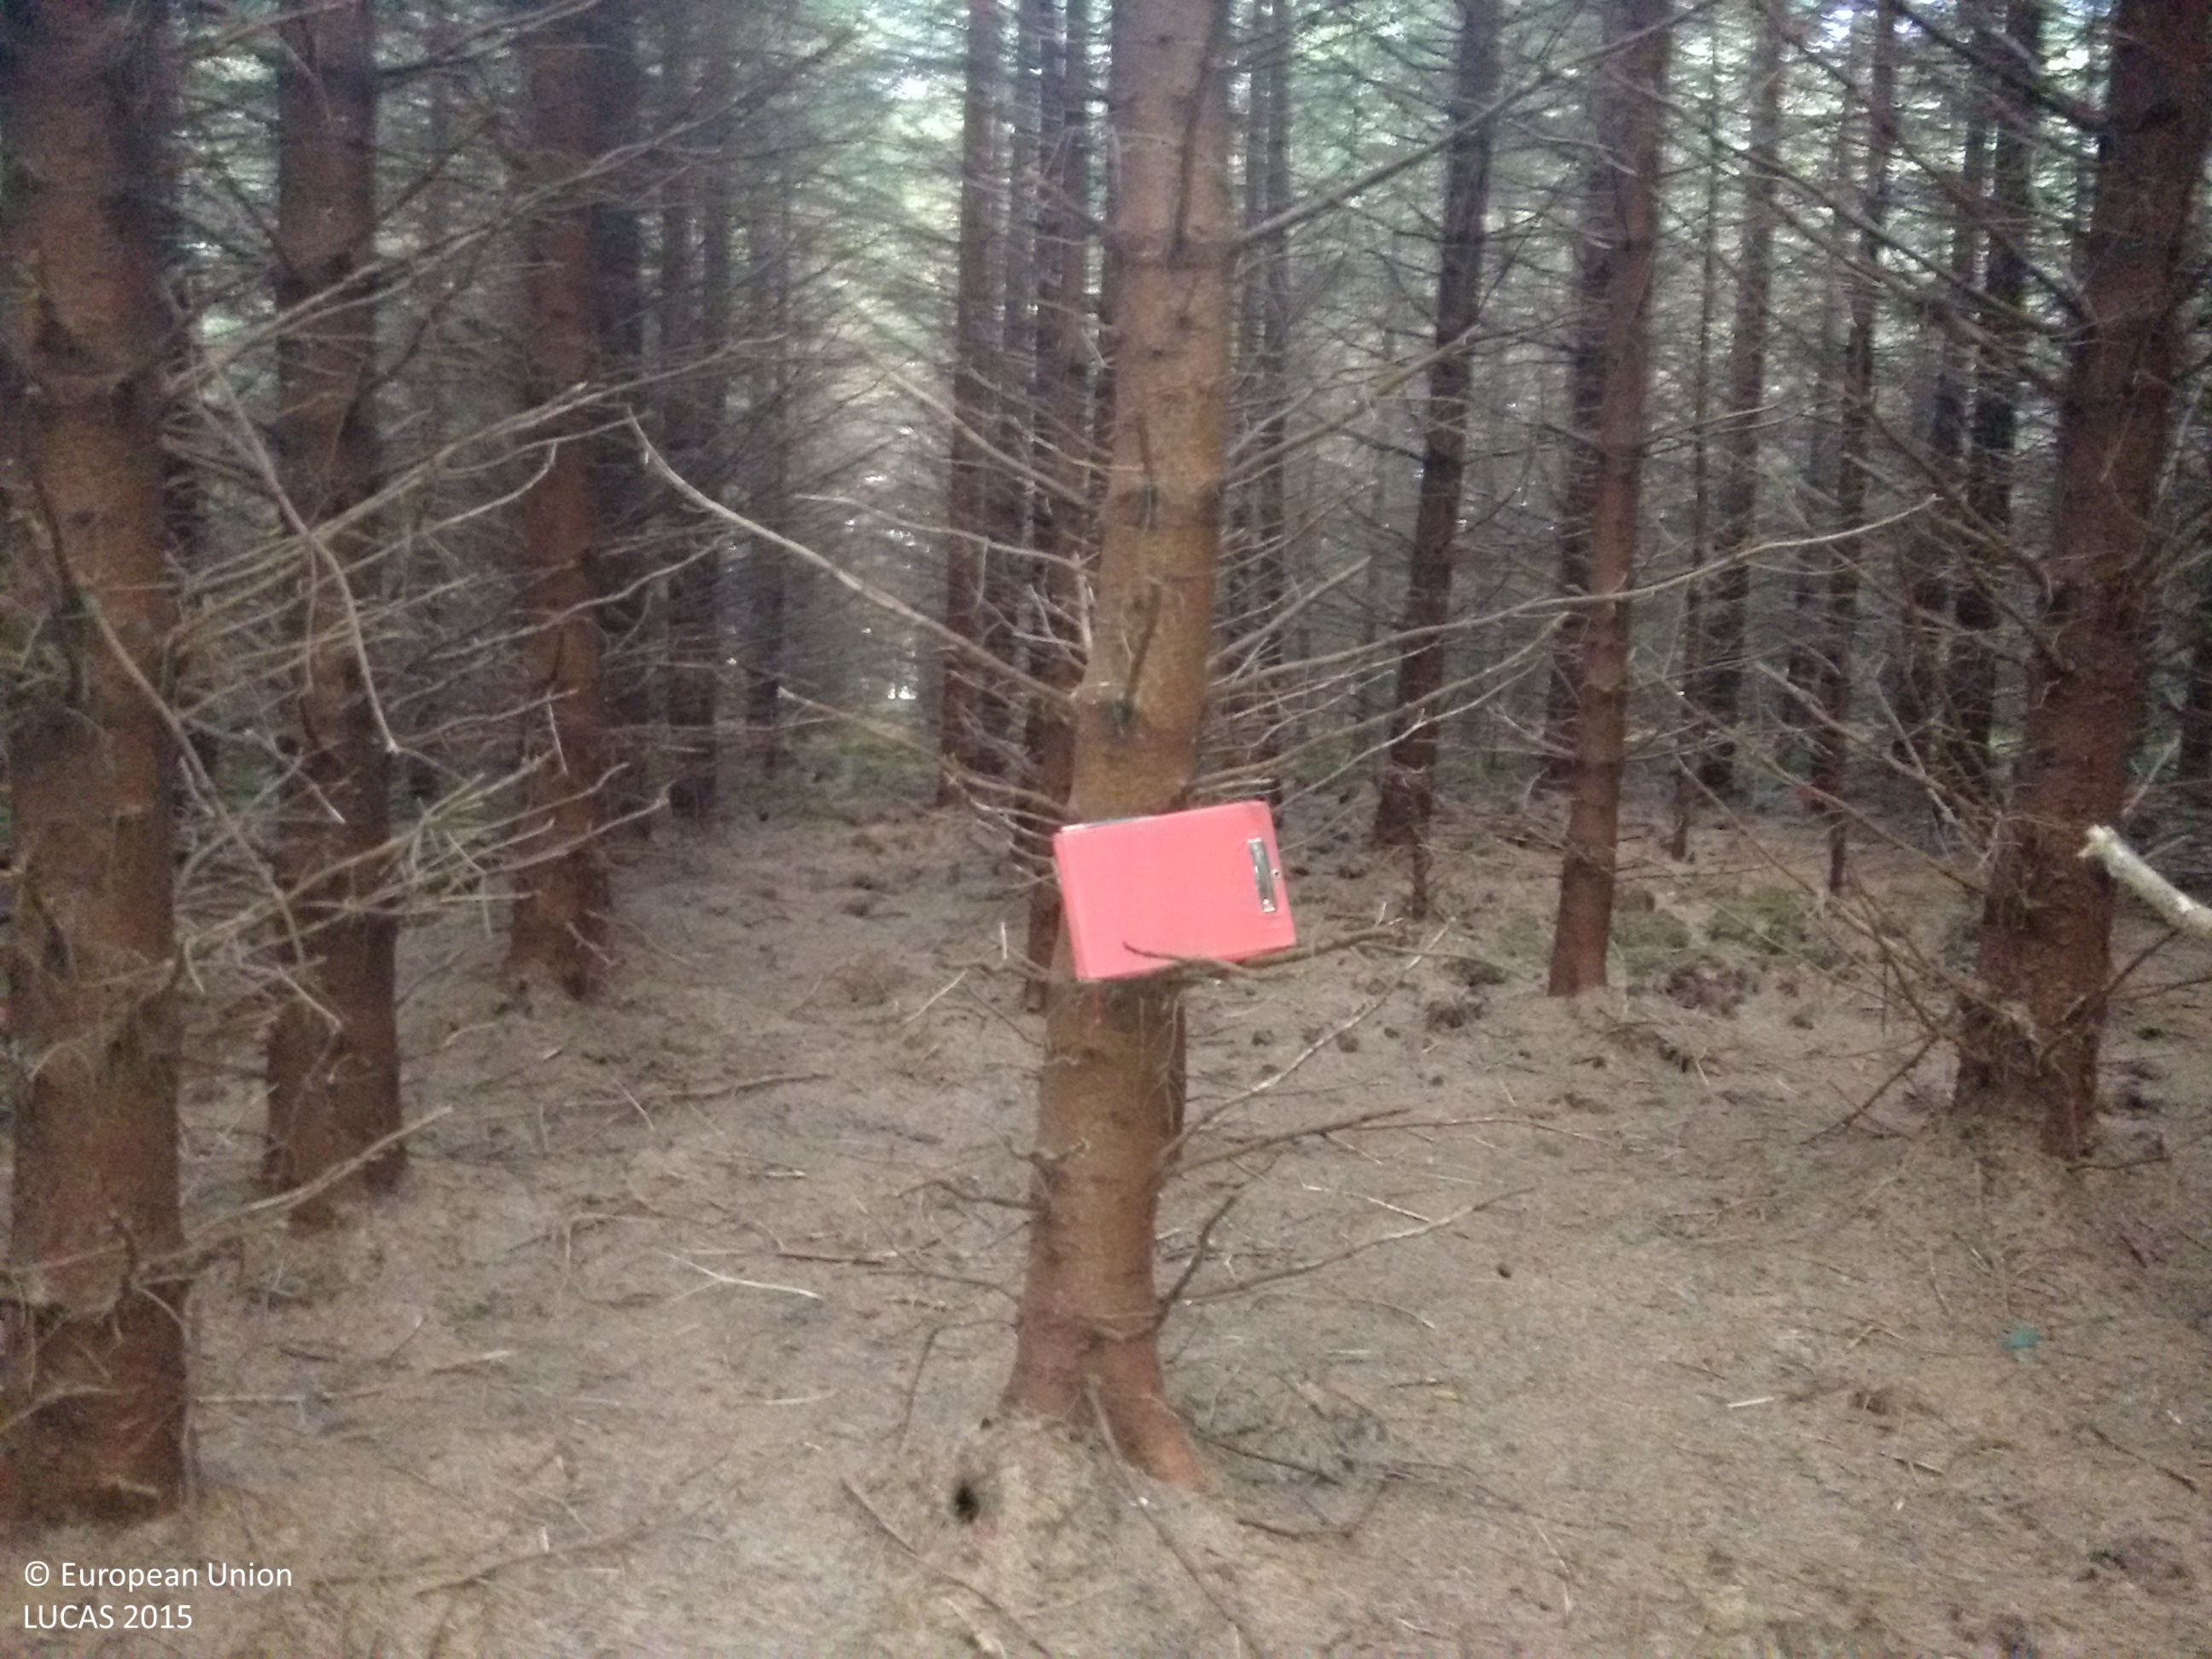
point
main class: Woodland
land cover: Spruce dominated coniferous woodland
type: exotic forest
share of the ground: > 75 %
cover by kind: coniferous forest trees 100 %
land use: Forestry
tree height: > 5 m
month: September
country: IE
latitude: 52.2065
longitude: -9.3529
